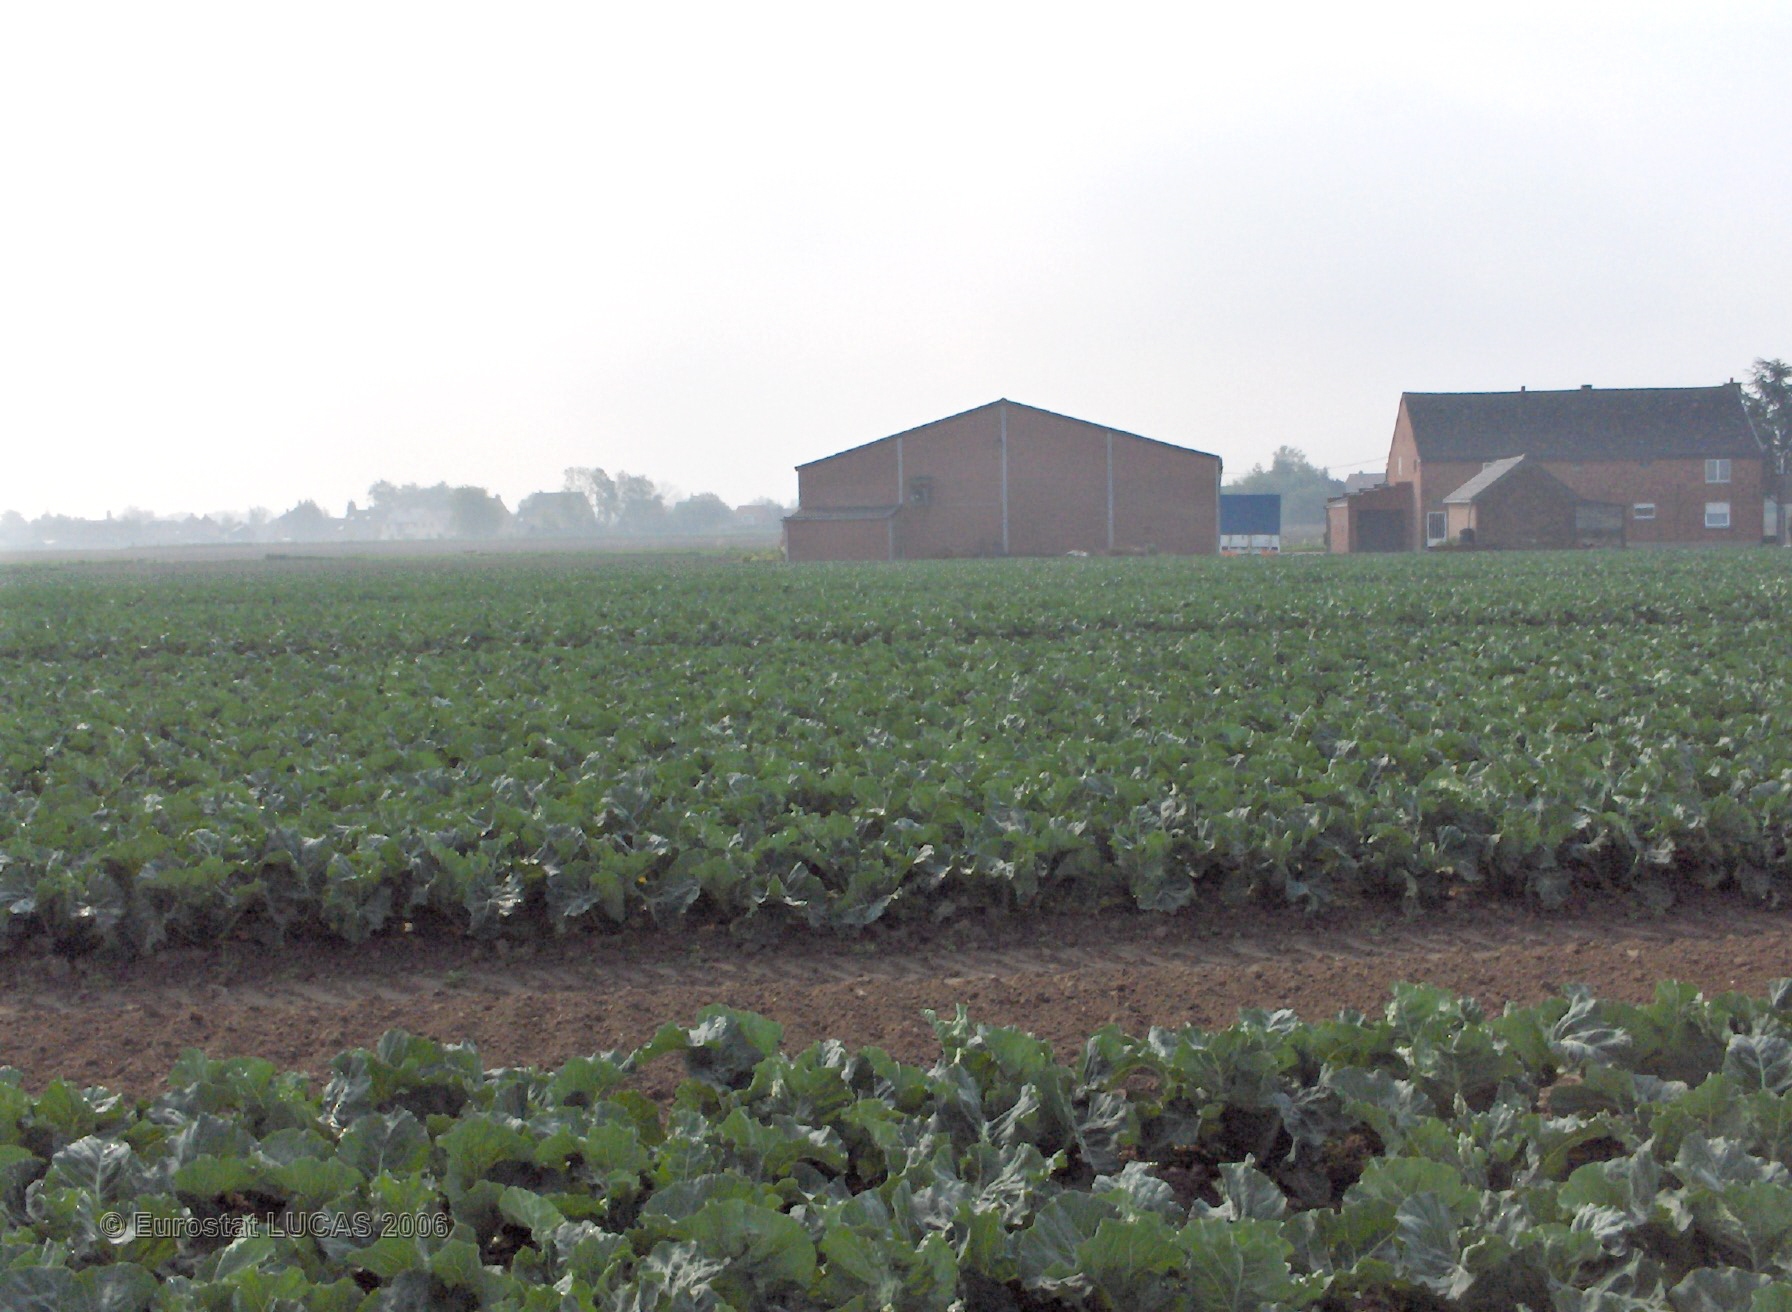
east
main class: Cropland
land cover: Other fresh vegetables
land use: Agriculture (excluding fallow land and kitchen gardens)
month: May
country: BE
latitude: 51.0210
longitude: 4.4214
